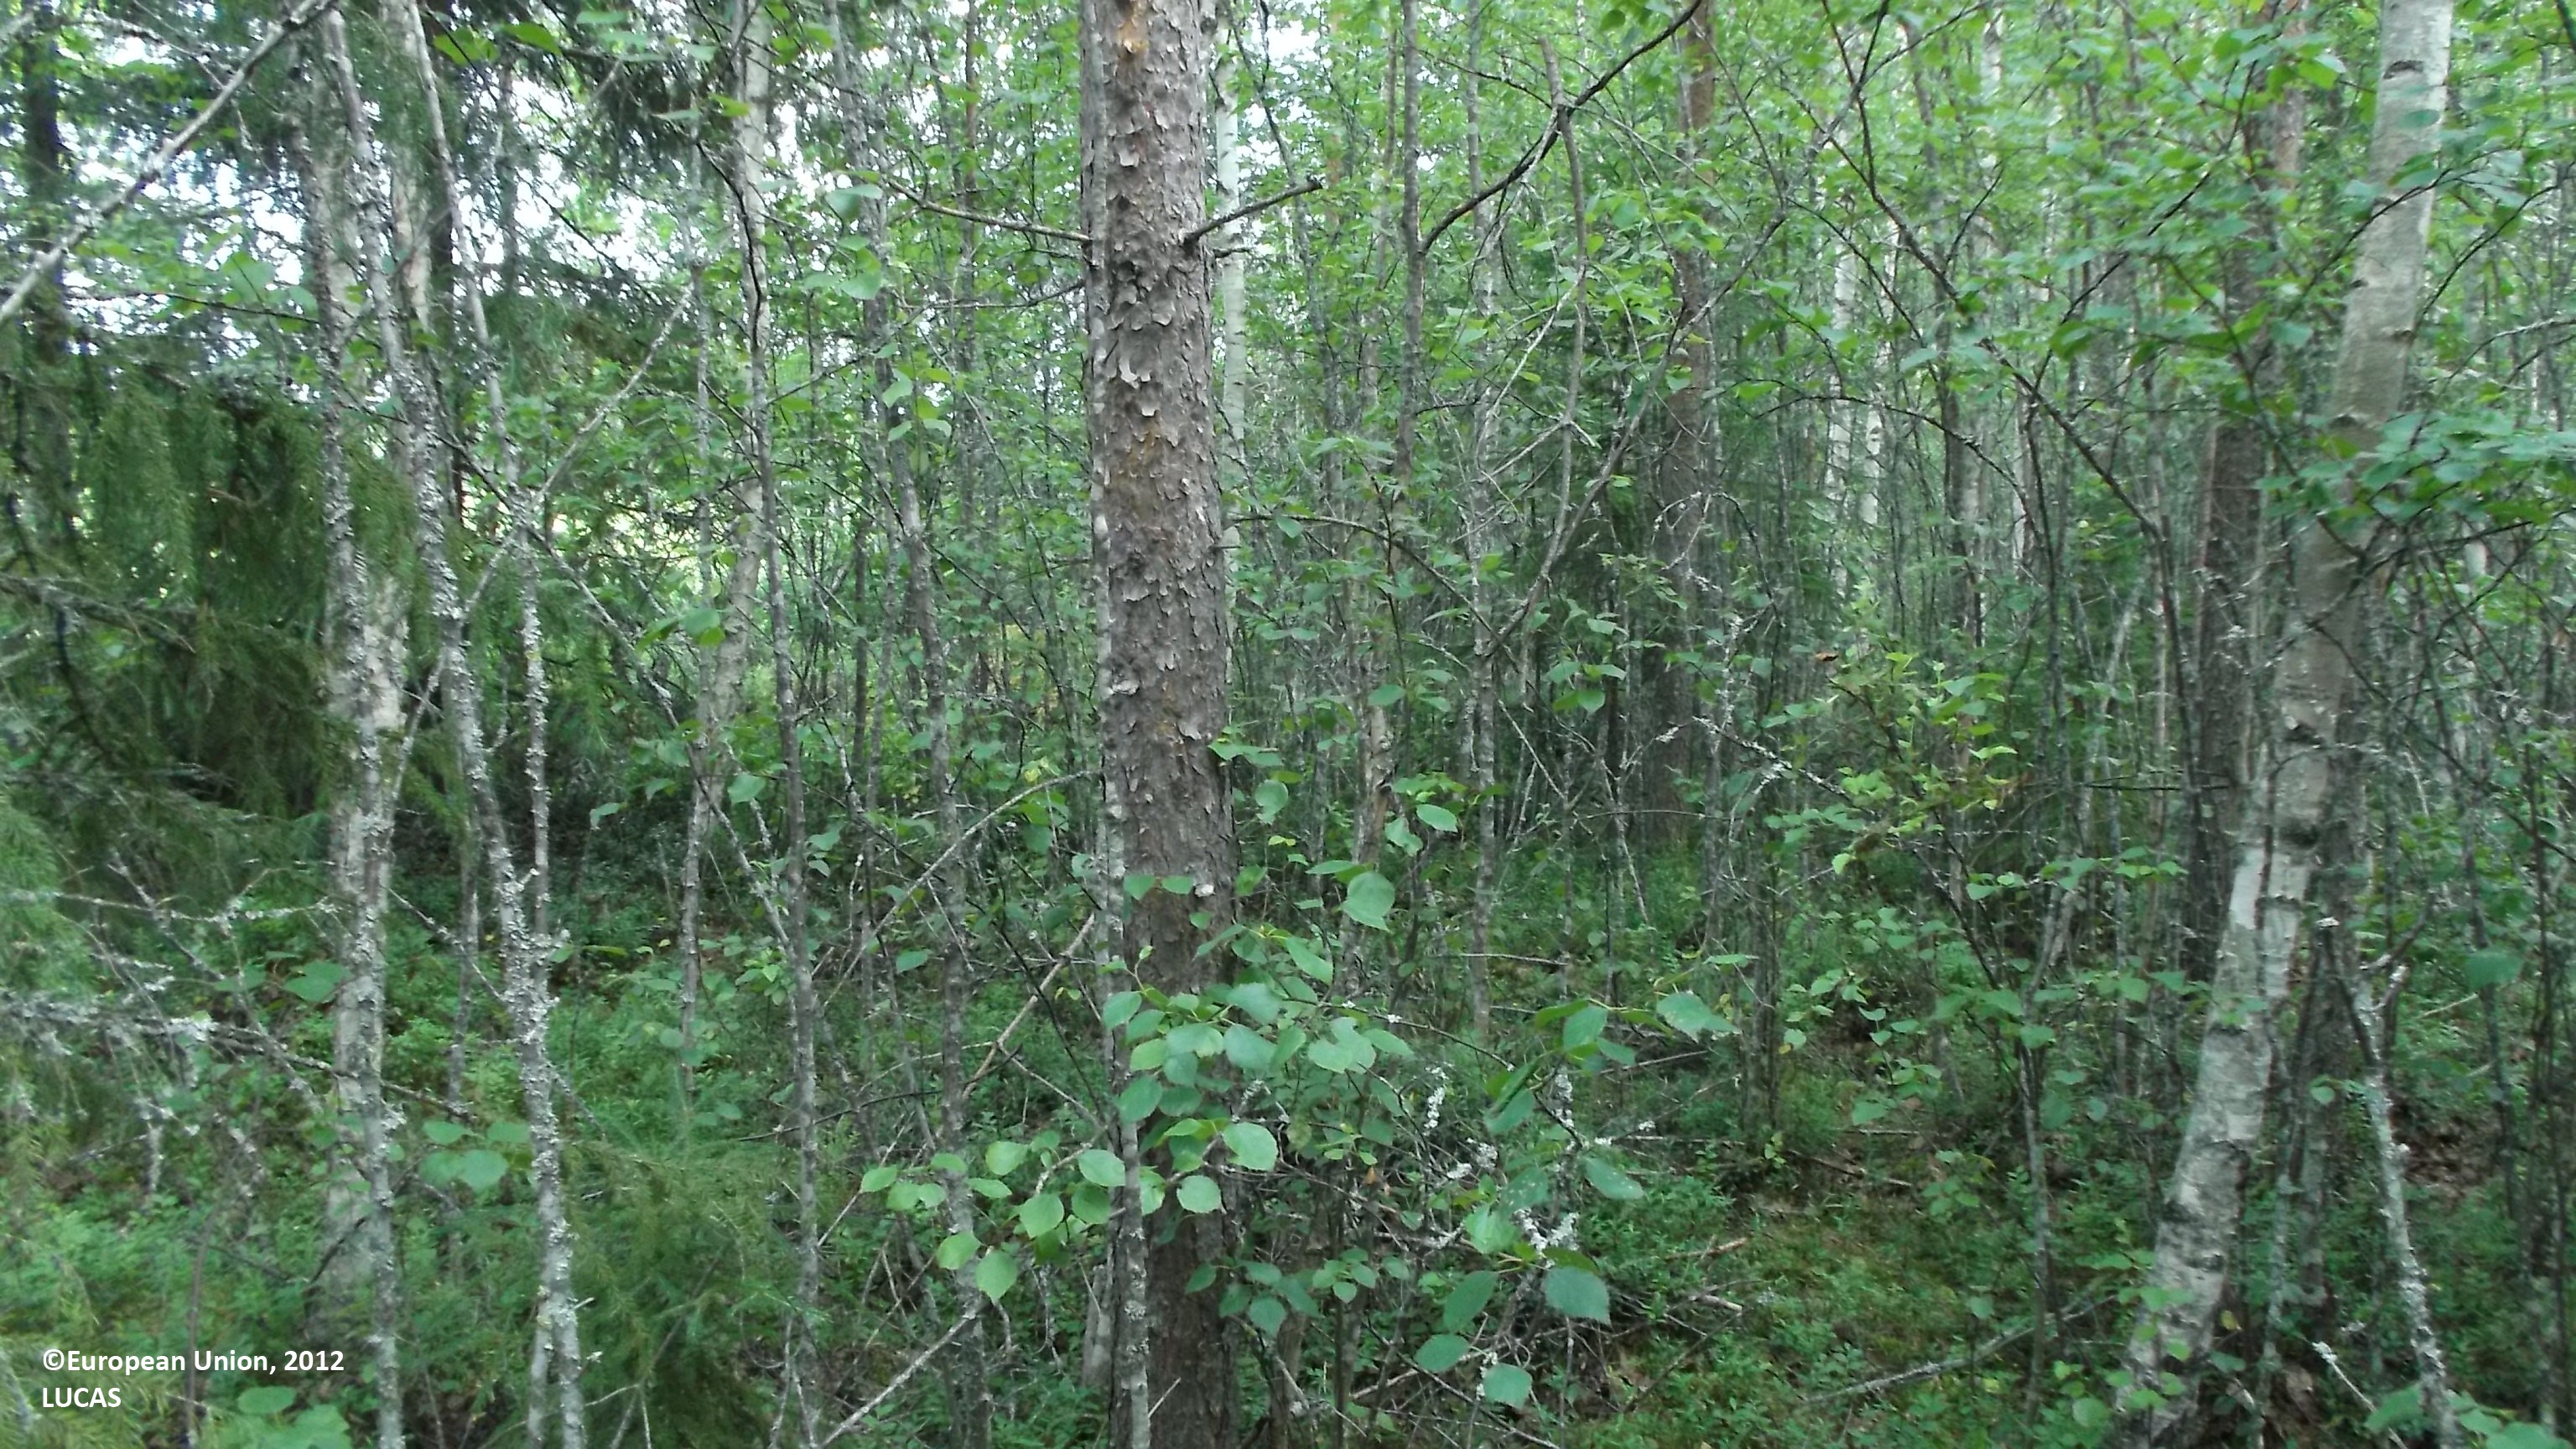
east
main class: Woodland
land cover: Spruce dominated mixed woodland
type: boreal forest
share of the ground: > 75 %
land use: Forestry
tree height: > 5 m
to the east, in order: Spruce dominated mixed woodland; Ditches and canals; Temporary grasslands; Spruce dominated mixed woodland; Spontaneously vegetated surfaces; Temporary grasslands
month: July
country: FI
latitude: 63.5915
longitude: 22.9296
